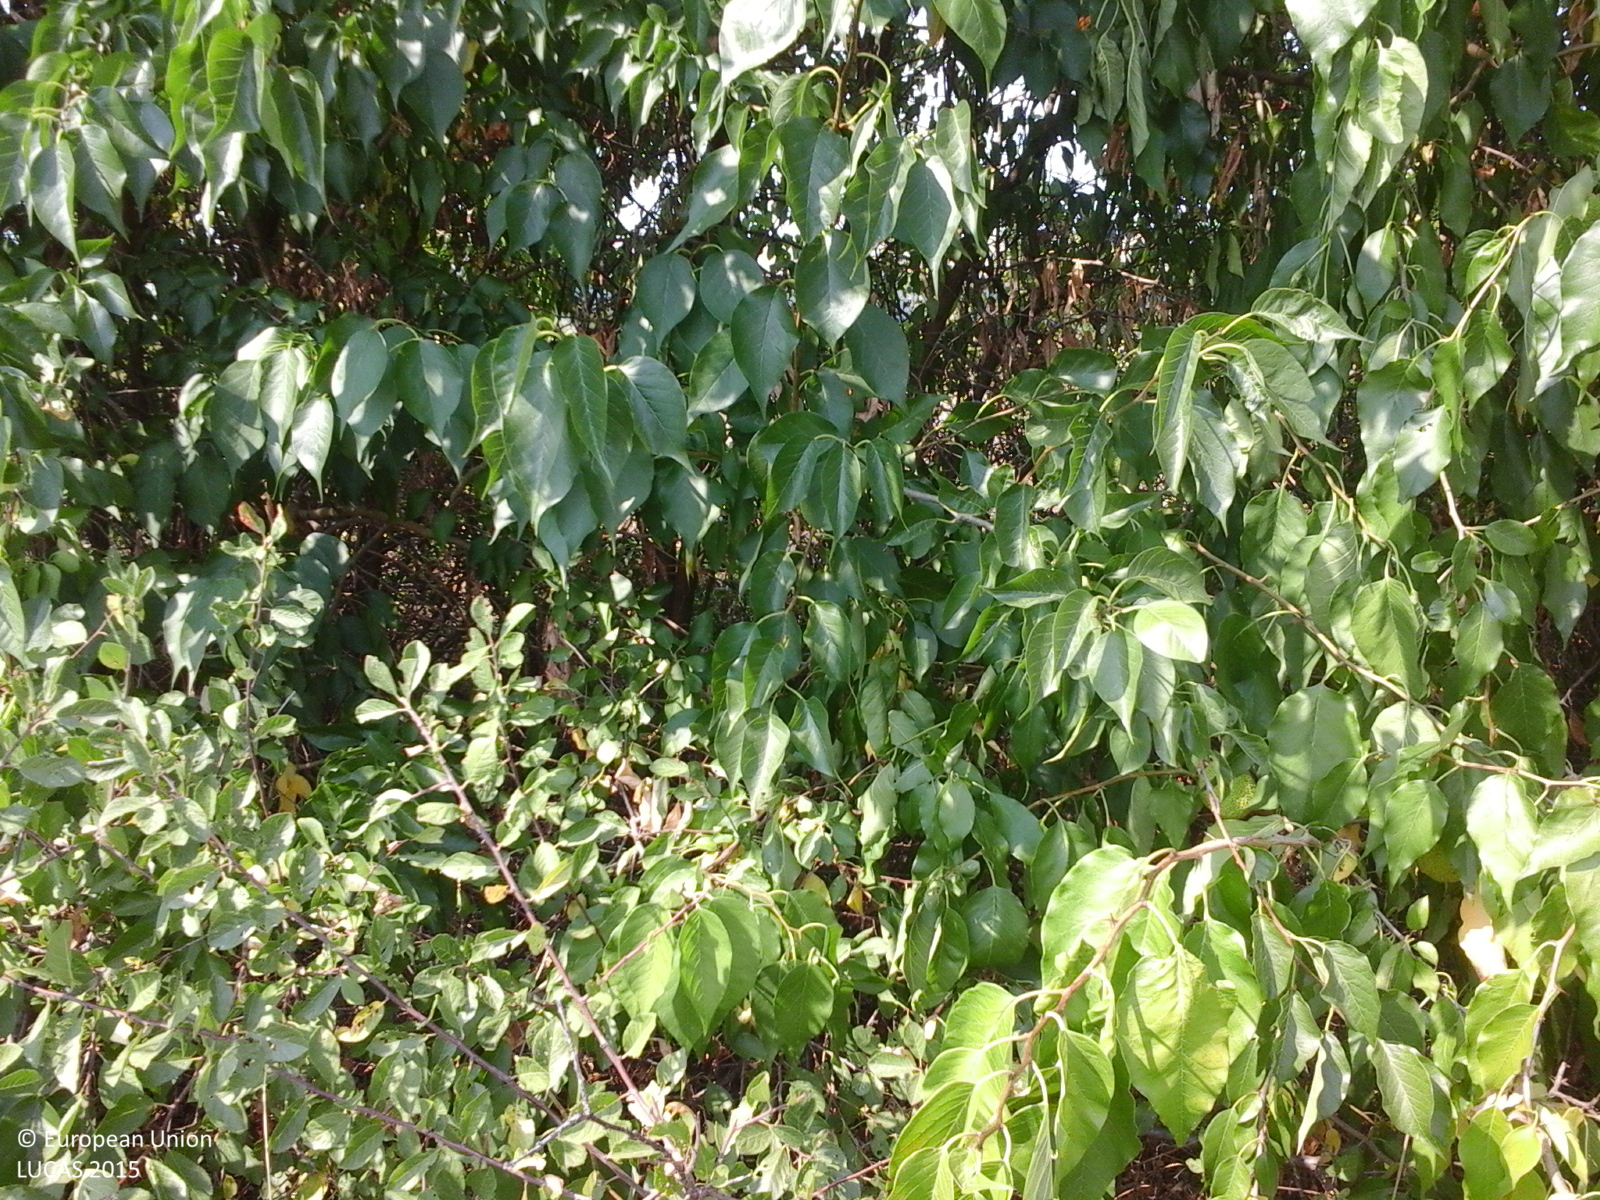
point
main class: Shrubland
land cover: Shrubland with sparse tree cover
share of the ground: > 75 %
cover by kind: shrubs 95 %, broadleaved forest trees 5 %
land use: Semi-natural and natural areas not in use
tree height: > 5 m
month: August
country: RO
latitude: 44.3680
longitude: 23.5683
